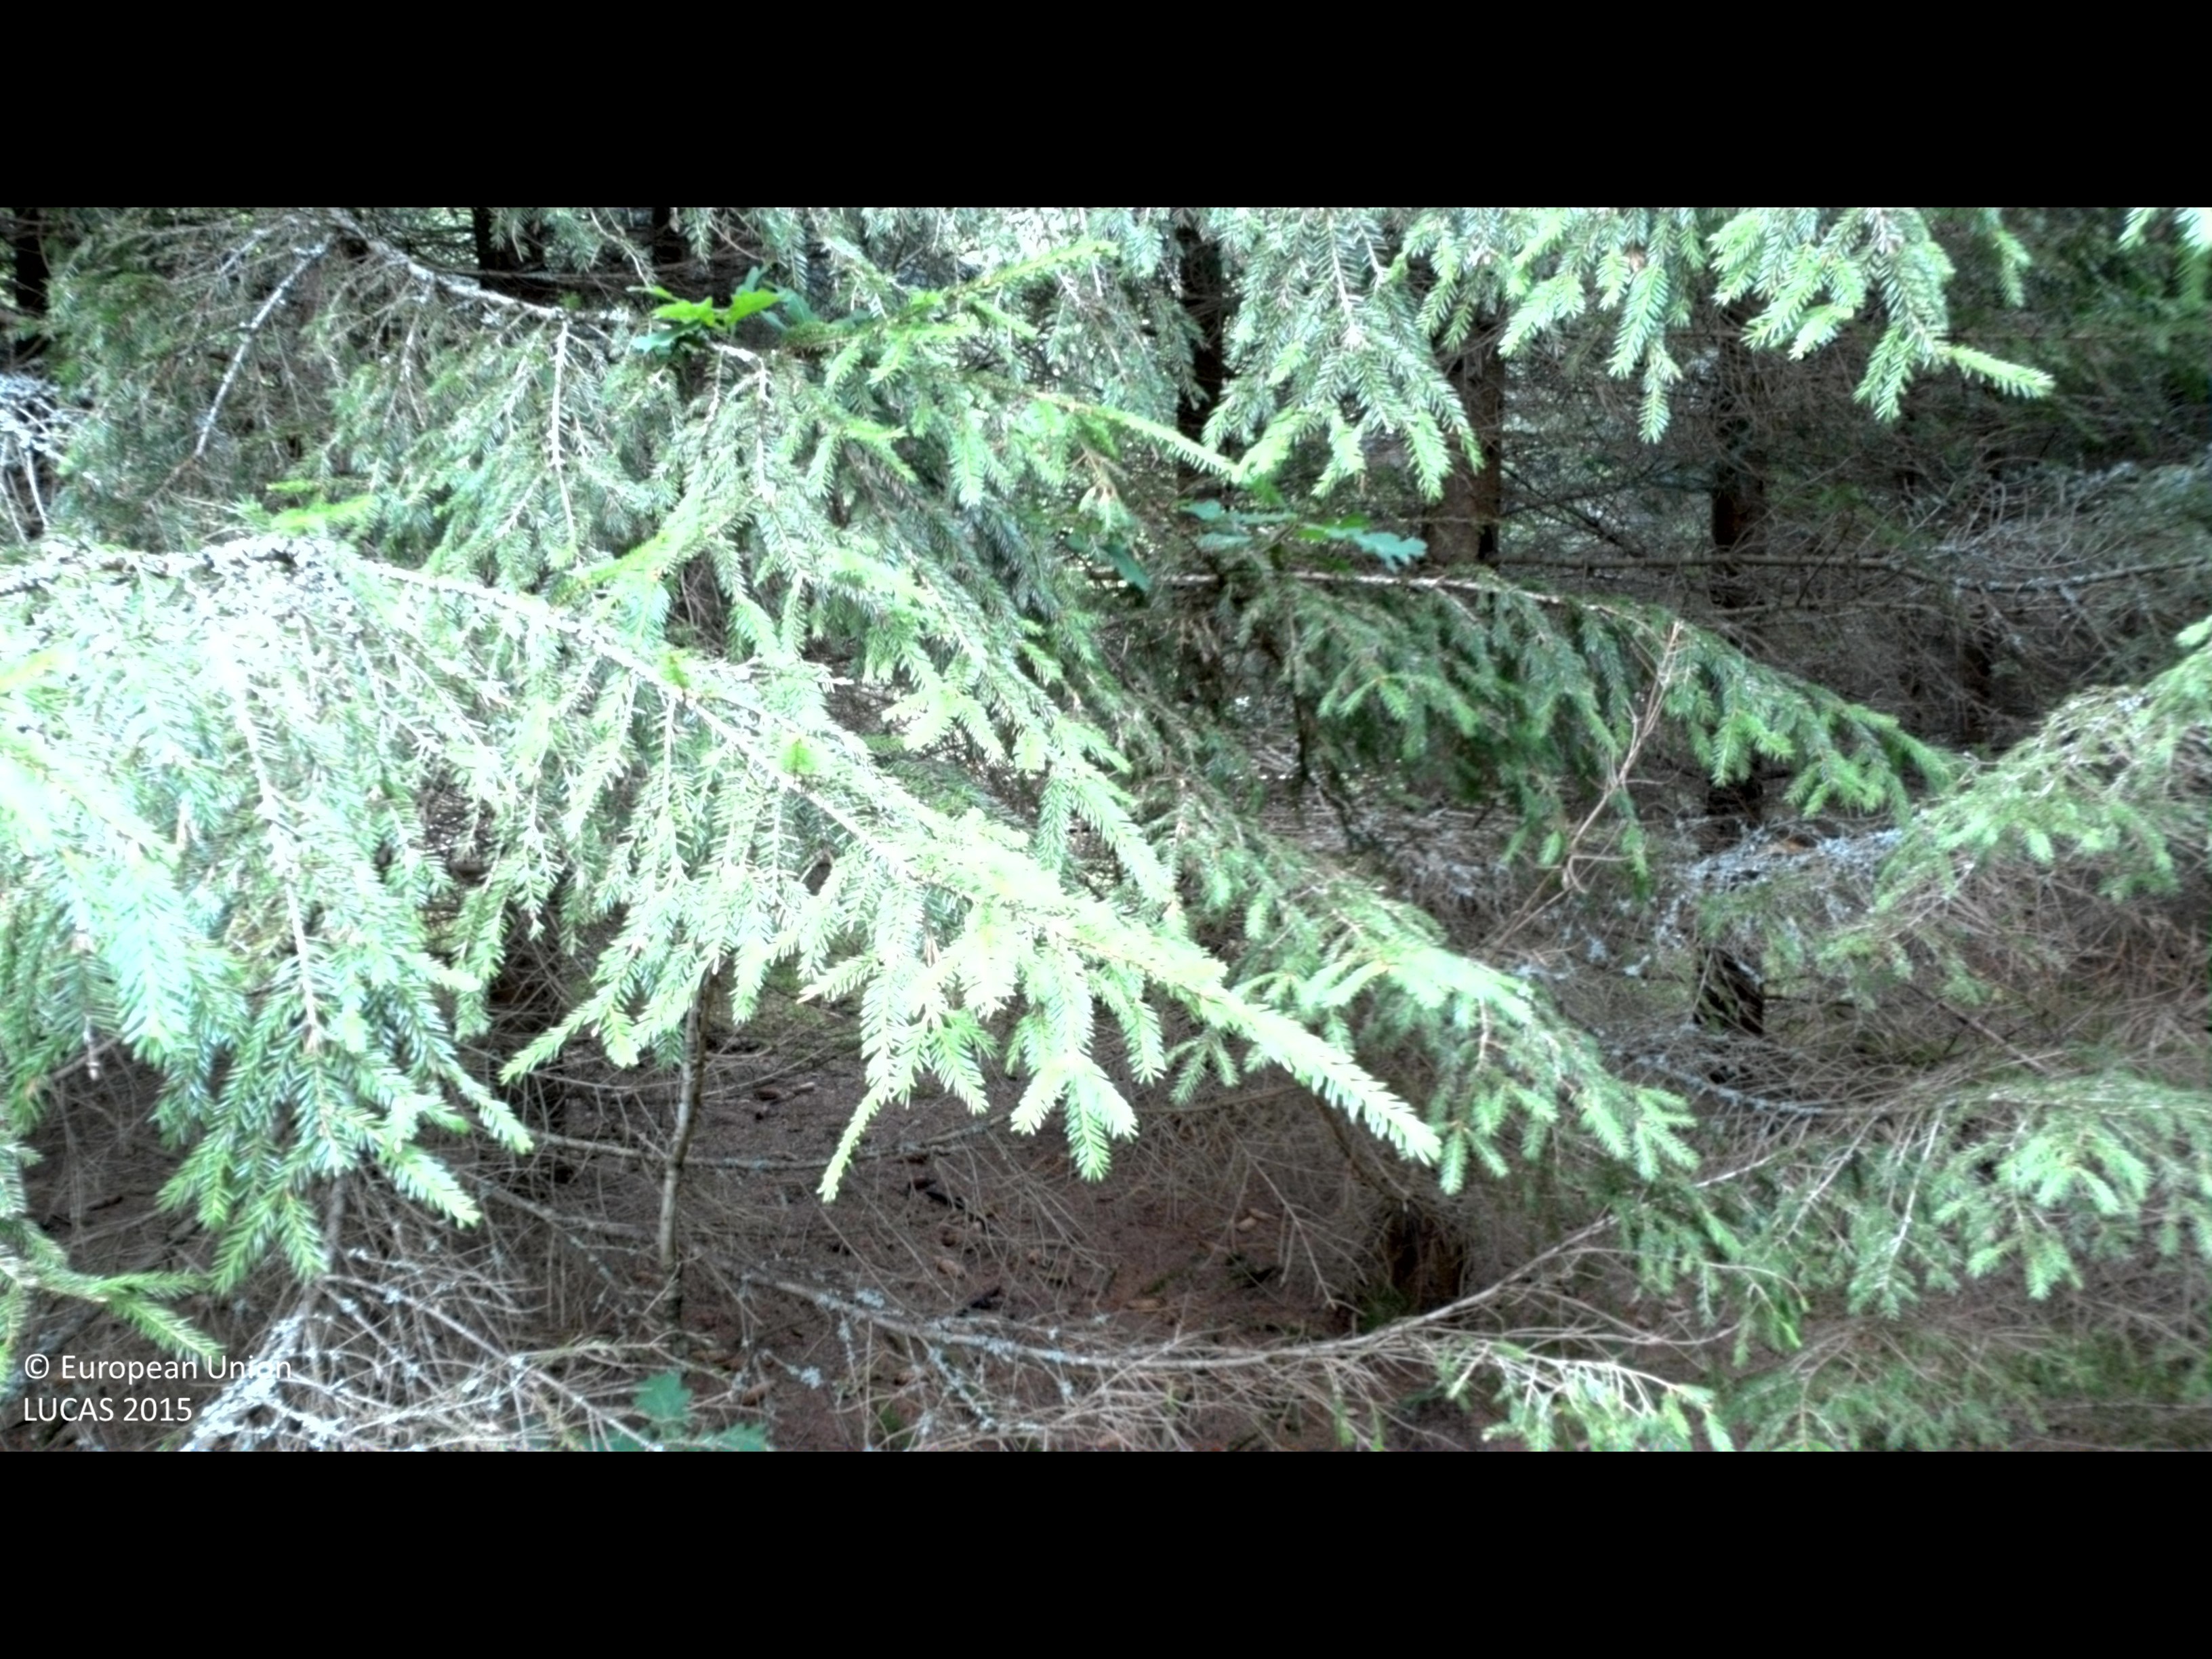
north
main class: Woodland
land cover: Spruce dominated coniferous woodland
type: boreal forest
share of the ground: 50 - 75 %
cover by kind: coniferous forest trees 65 %, lichens and mosses 25 %, broadleaved forest trees 5 %, herbaceous plants 5 %
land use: Forestry
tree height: > 5 m
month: August
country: SE
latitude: 56.3018
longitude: 15.1217
